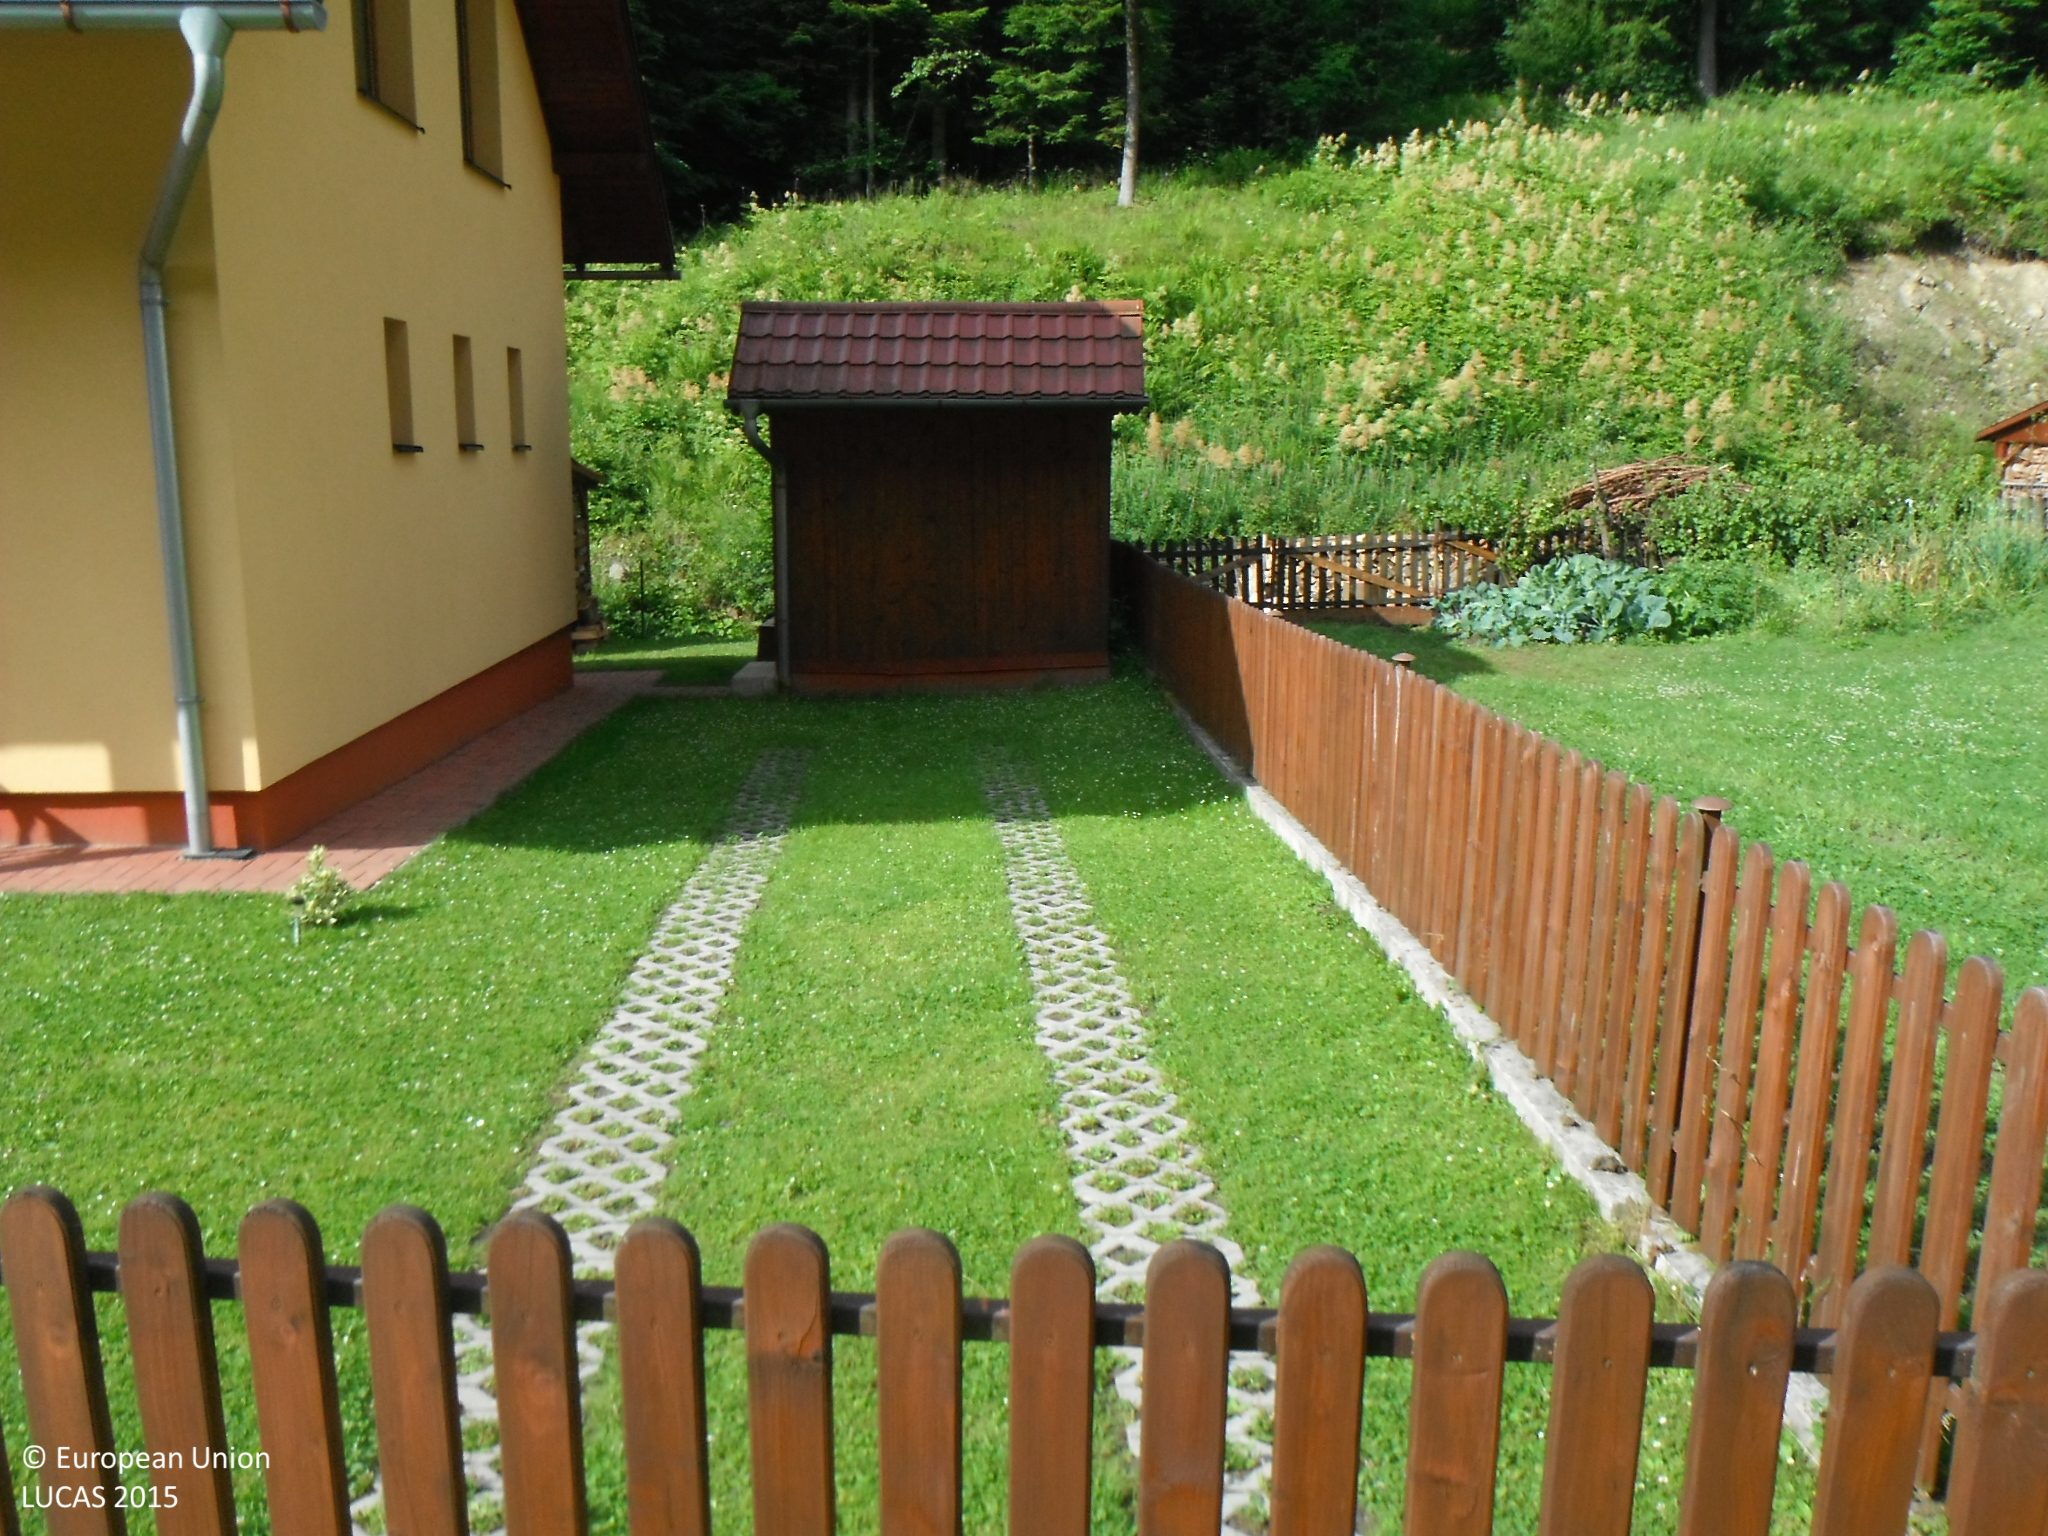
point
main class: Grassland
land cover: Grassland without tree/shrub cover
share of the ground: > 75 %
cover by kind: herbaceous plants 95 %
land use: Residential
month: July
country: SK
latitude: 49.4304
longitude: 18.5260
